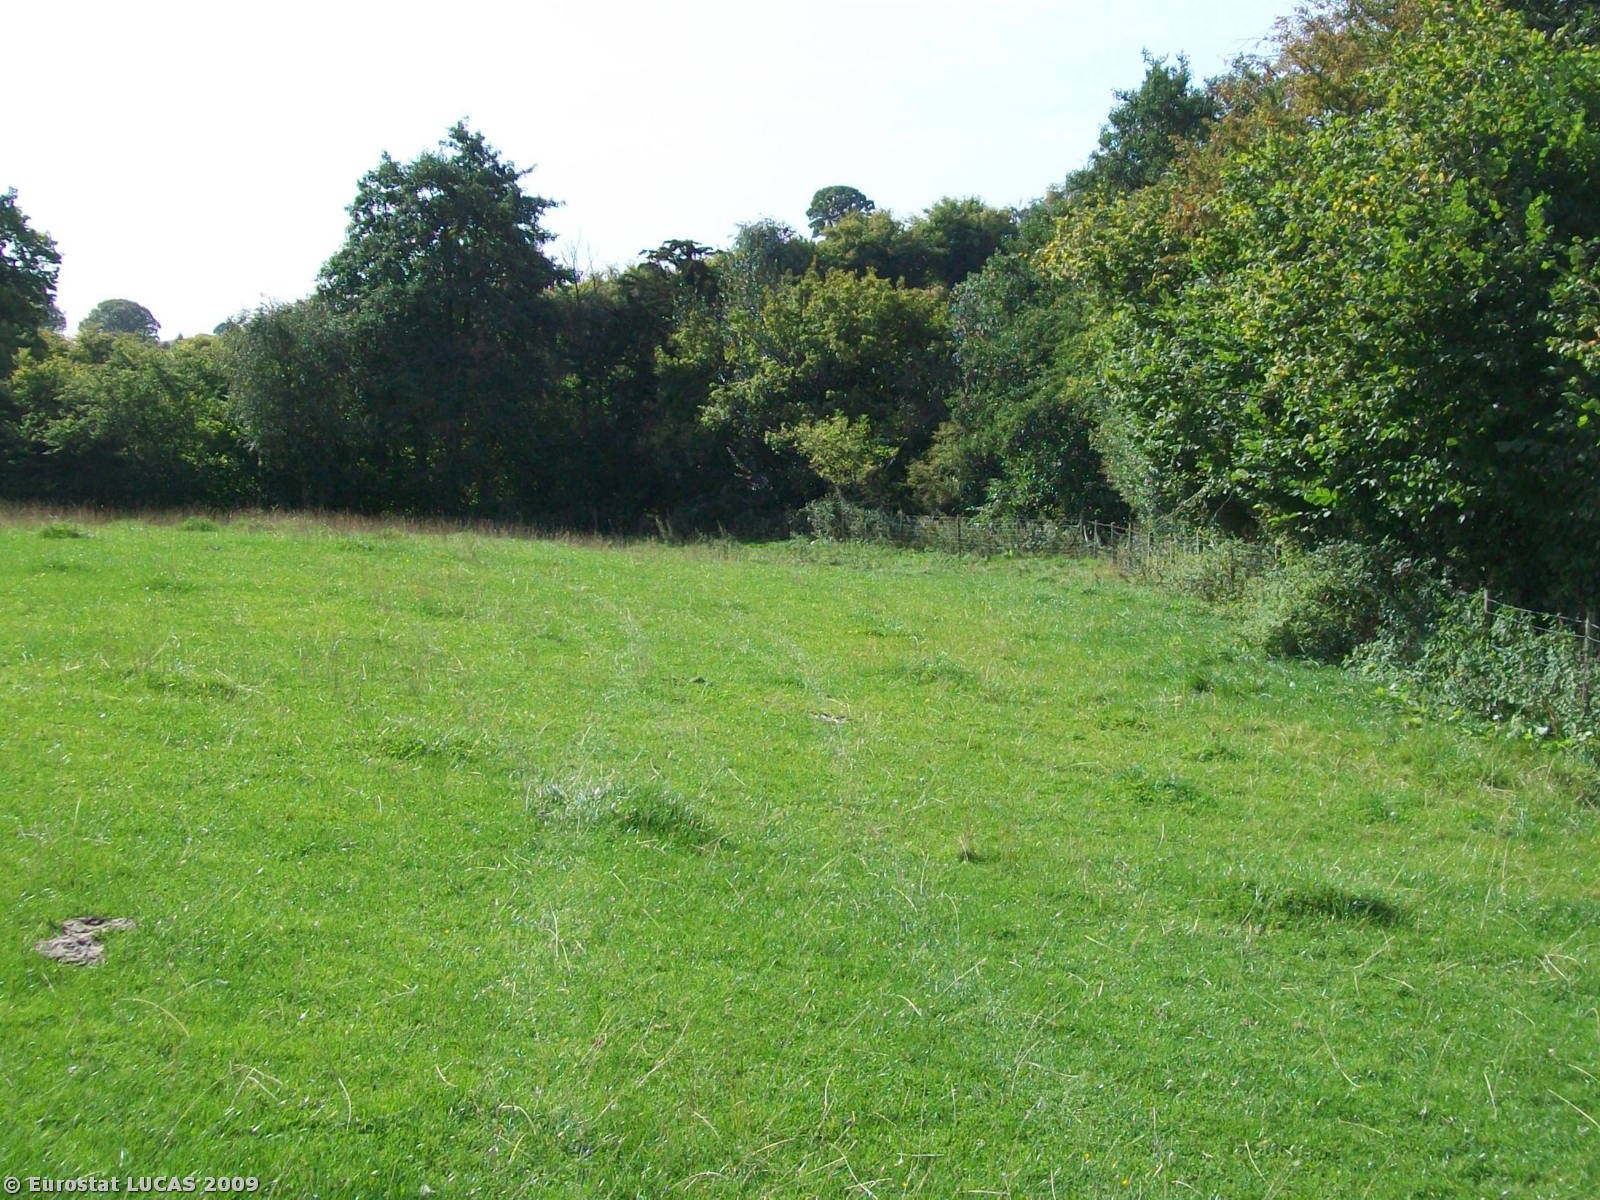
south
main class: Grassland
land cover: Grassland without tree/shrub cover
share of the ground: > 75 %
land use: Agriculture (excluding fallow land and kitchen gardens)
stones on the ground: < 10 %
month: September
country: GB
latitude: 52.2652
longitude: -2.4470
